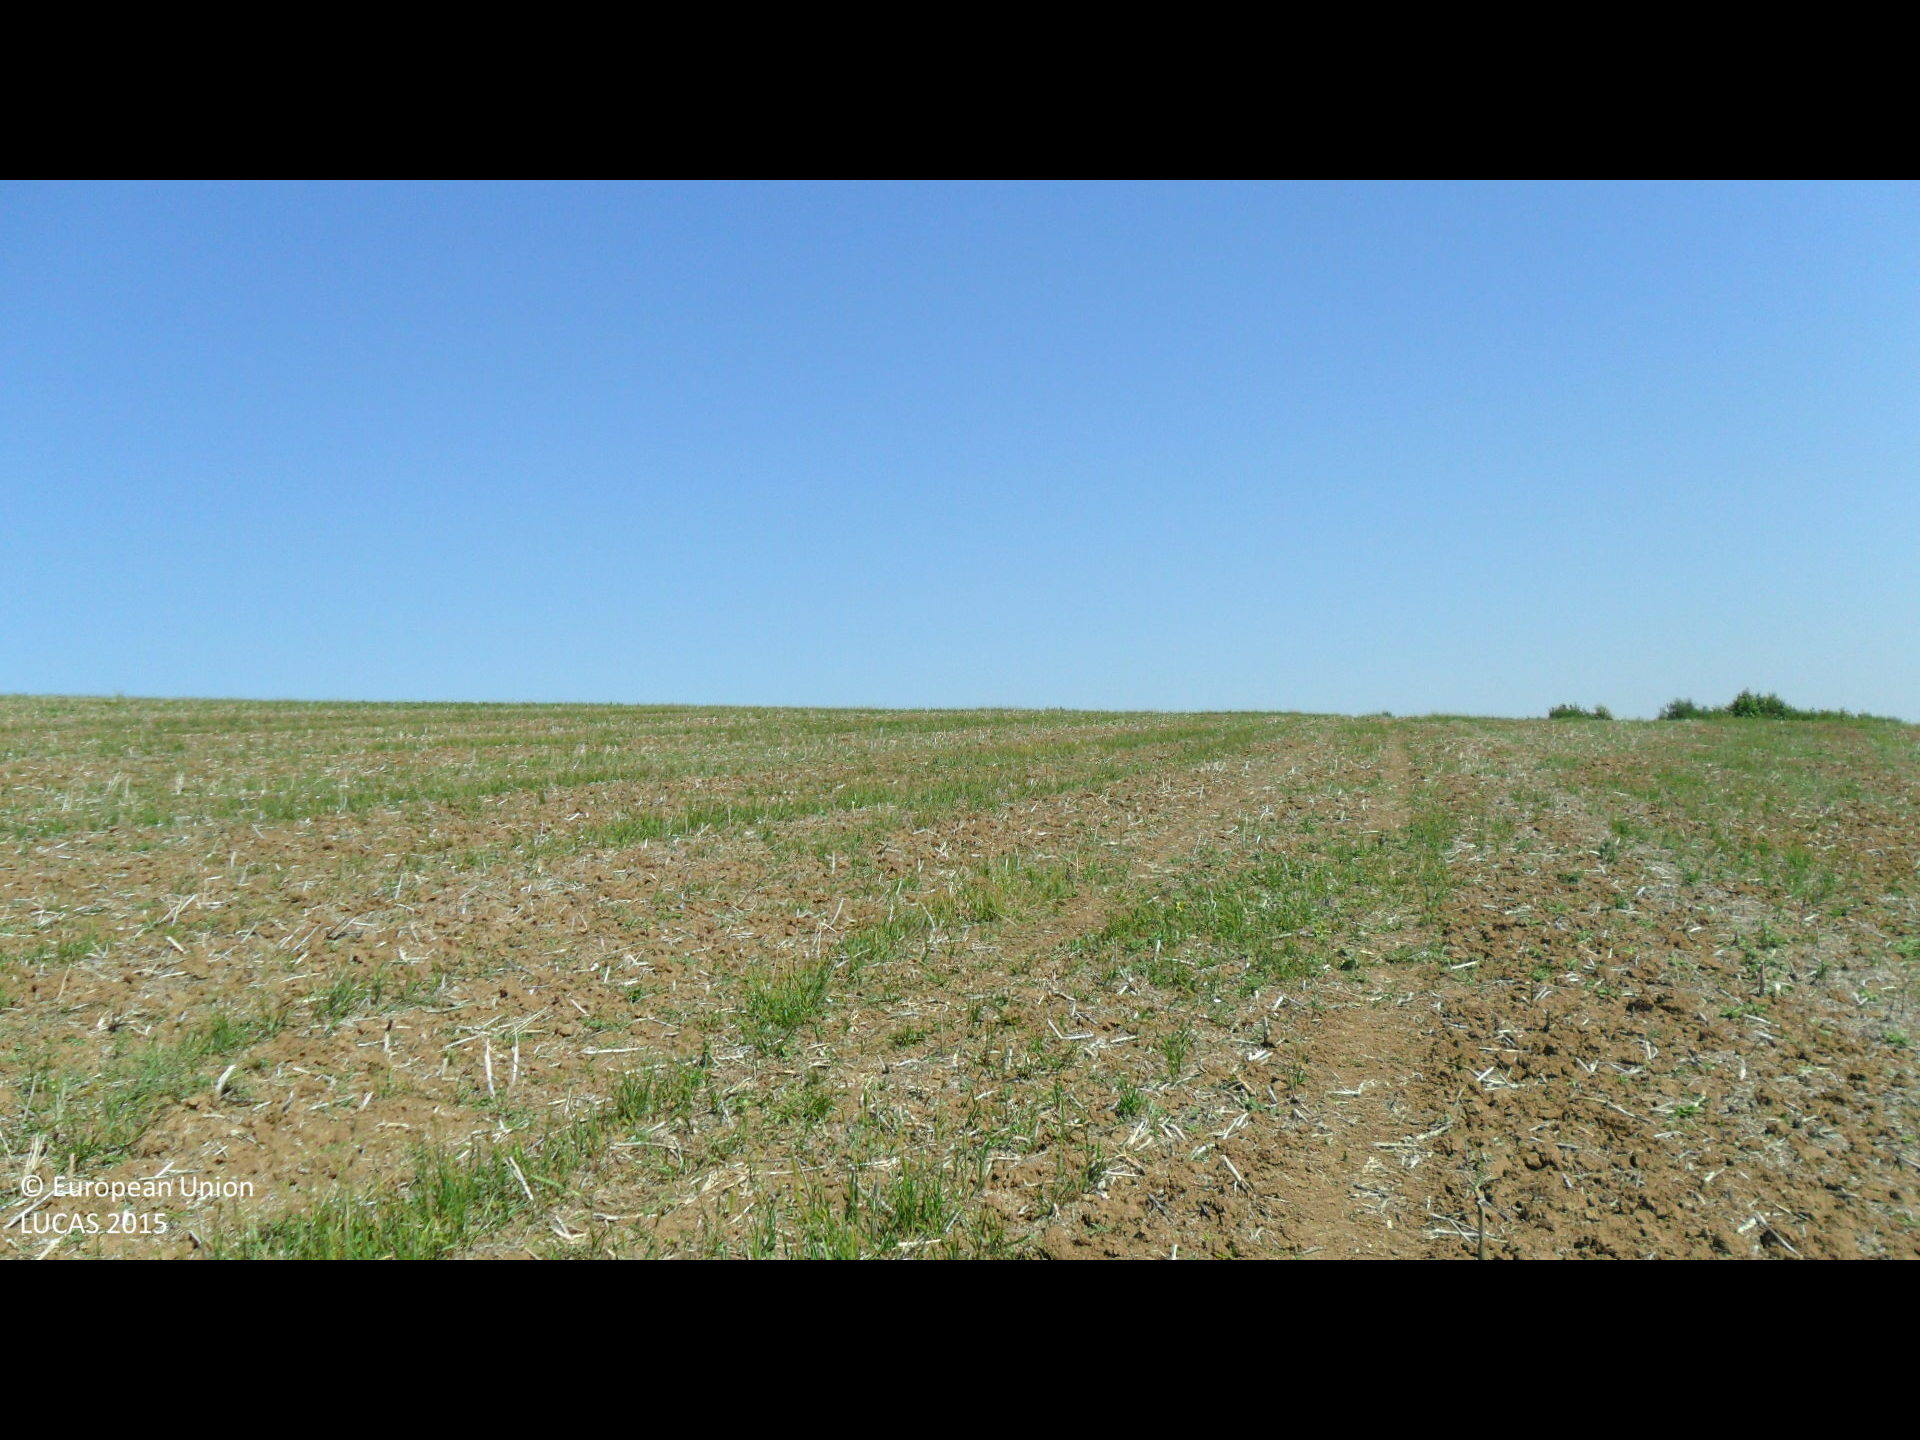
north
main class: Cropland
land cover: Rape and turnip rape
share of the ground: < 10 %
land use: Agriculture (excluding fallow land and kitchen gardens)
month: August
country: BG
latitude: 43.5021
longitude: 26.2384
